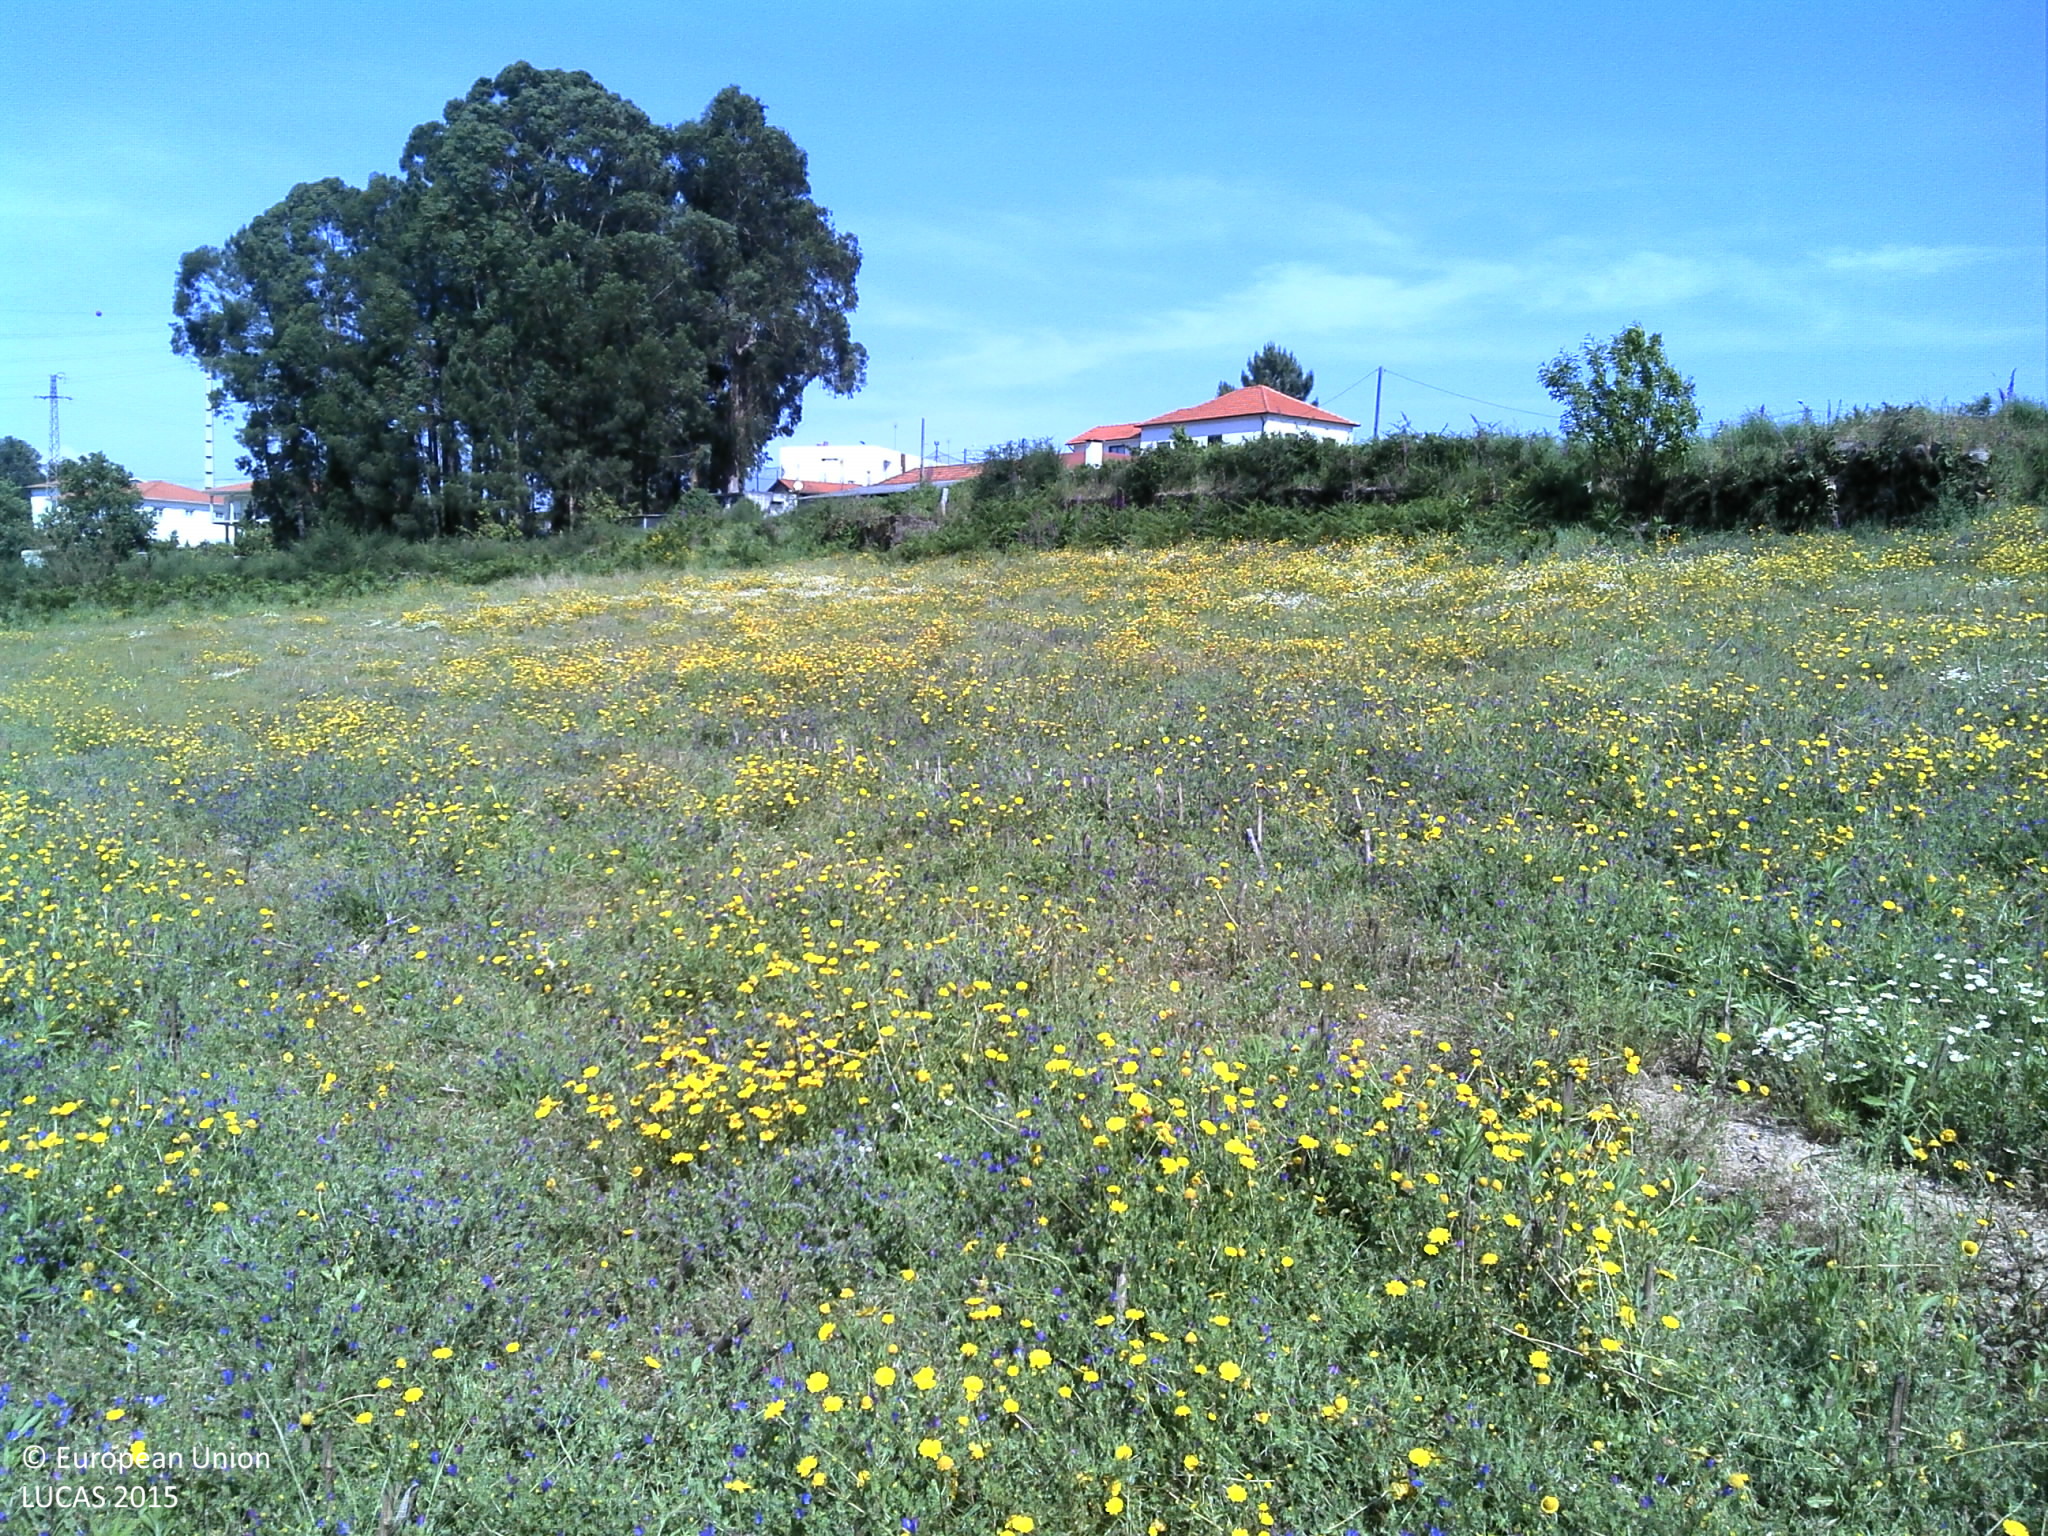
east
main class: Grassland
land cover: Grassland without tree/shrub cover
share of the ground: 50 - 75 %
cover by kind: herbaceous plants 95 %, unconsolidated bare surface 5 %
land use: Agriculture (excluding fallow land and kitchen gardens)
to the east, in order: Grassland without tree/shrub cover; Dry stone walls; Artificial constructions in urban areas; Shrubland without tree cover; Dry stone walls; Artificial constructions in urban areas
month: May
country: PT
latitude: 41.3570
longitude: -8.5011
